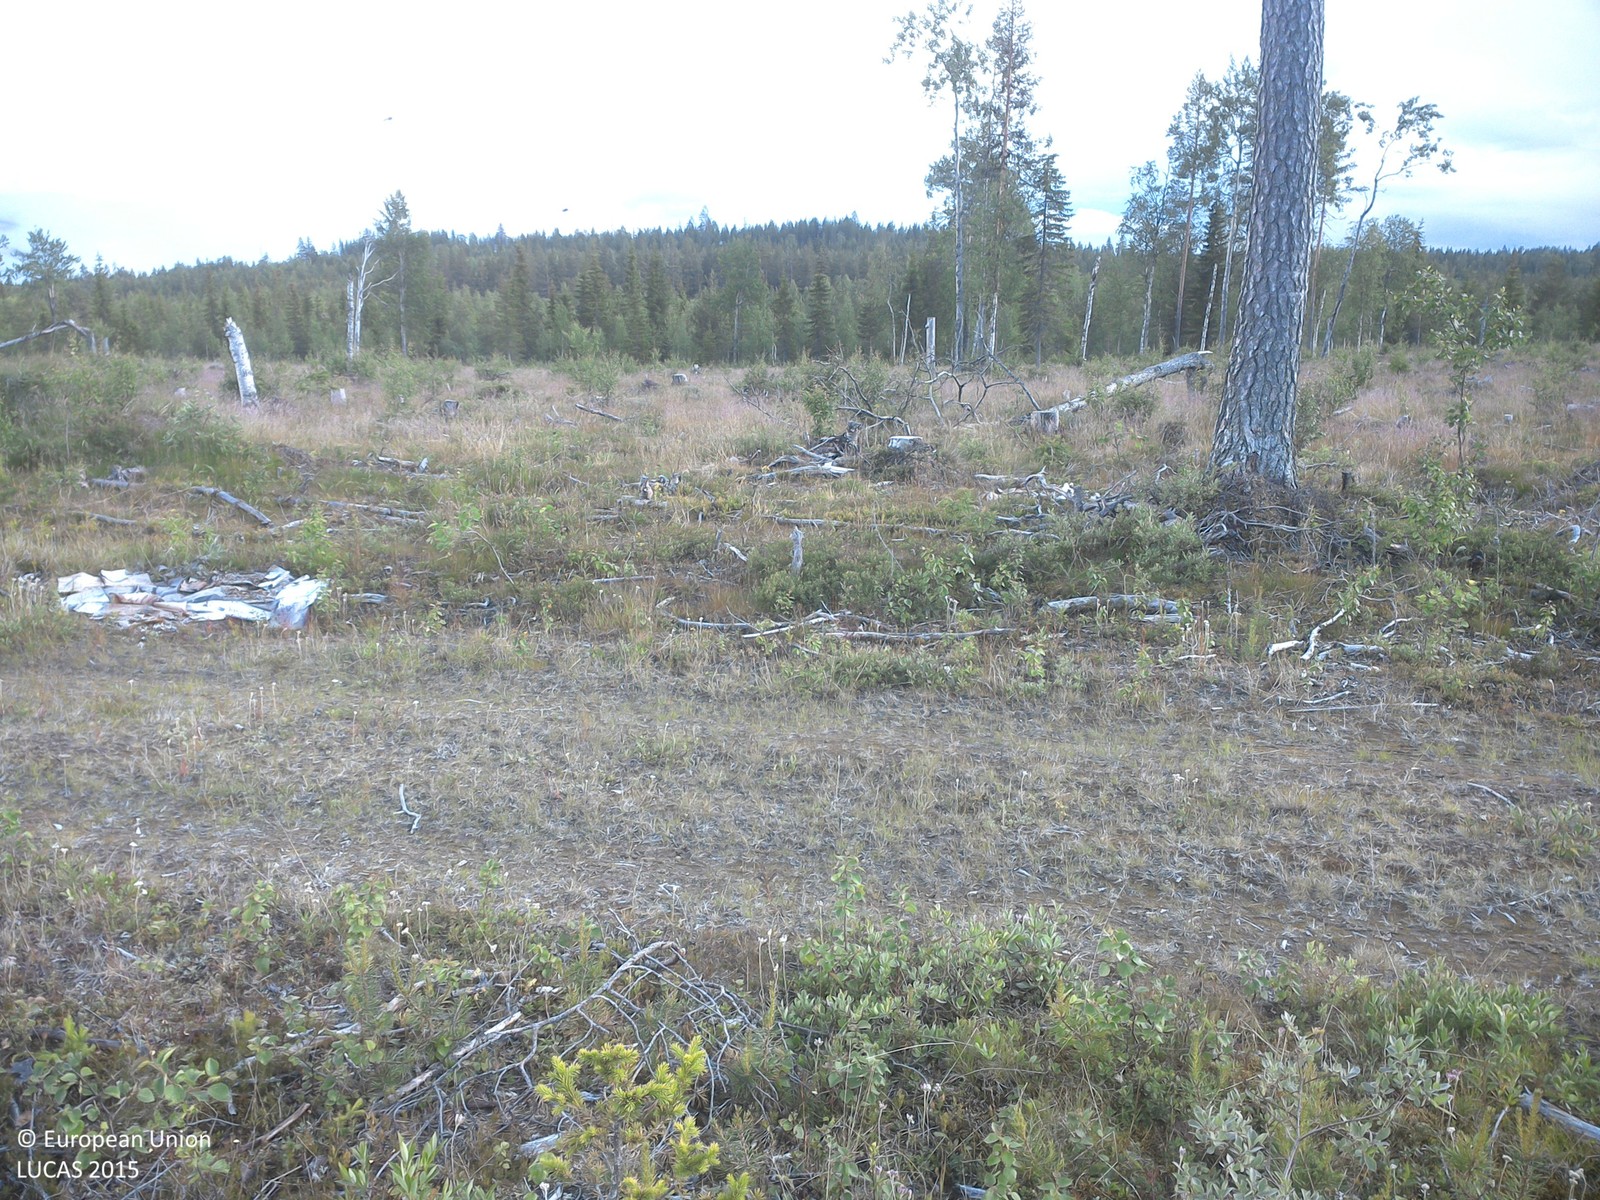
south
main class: Shrubland
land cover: Shrubland with sparse tree cover
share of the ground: 25 - 50 %
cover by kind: herbaceous plants 40 %, shrubs 25 %, unconsolidated bare surface 20 %, lichens and mosses 10 %, broadleaved forest trees 5 %
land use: Forestry
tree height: < 5 m
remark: Clear cut
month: July
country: SE
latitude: 67.7076
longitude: 23.4541
